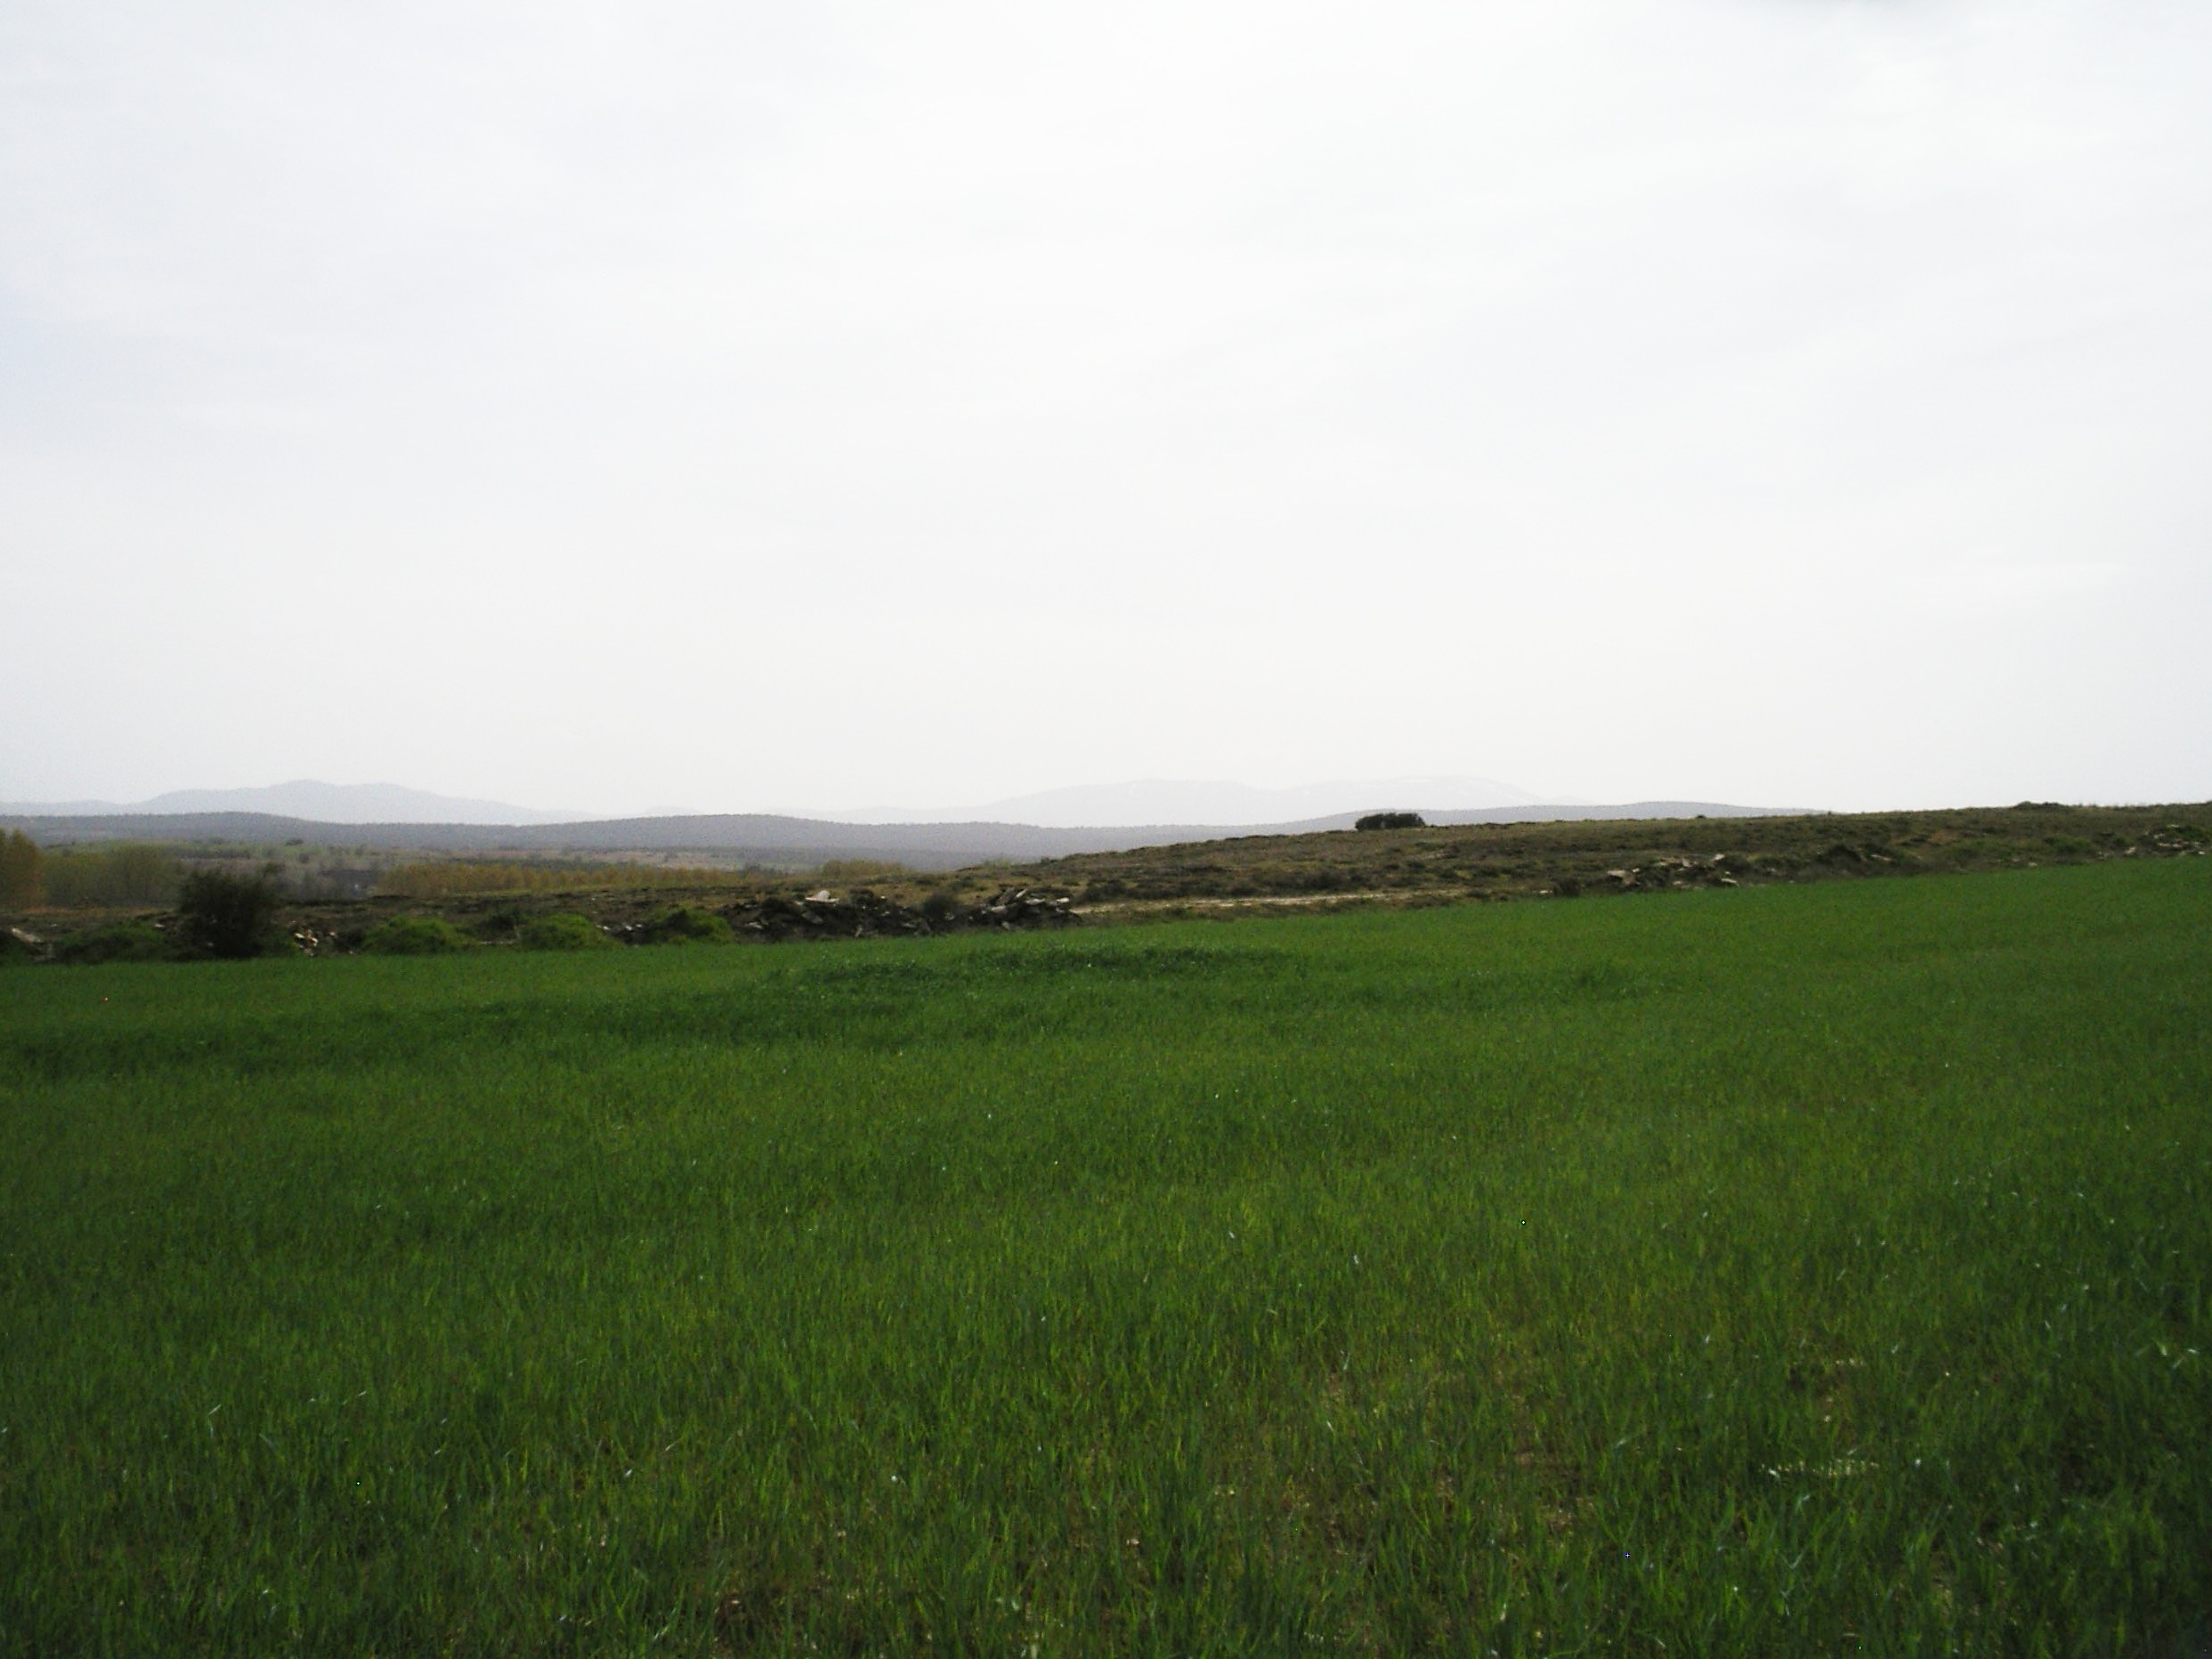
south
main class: Cropland
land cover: Barley
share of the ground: > 75 %
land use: Agriculture (excluding fallow land and kitchen gardens)
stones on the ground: 10 - 25 %
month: April
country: ES
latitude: 42.4338
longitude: -6.1408
